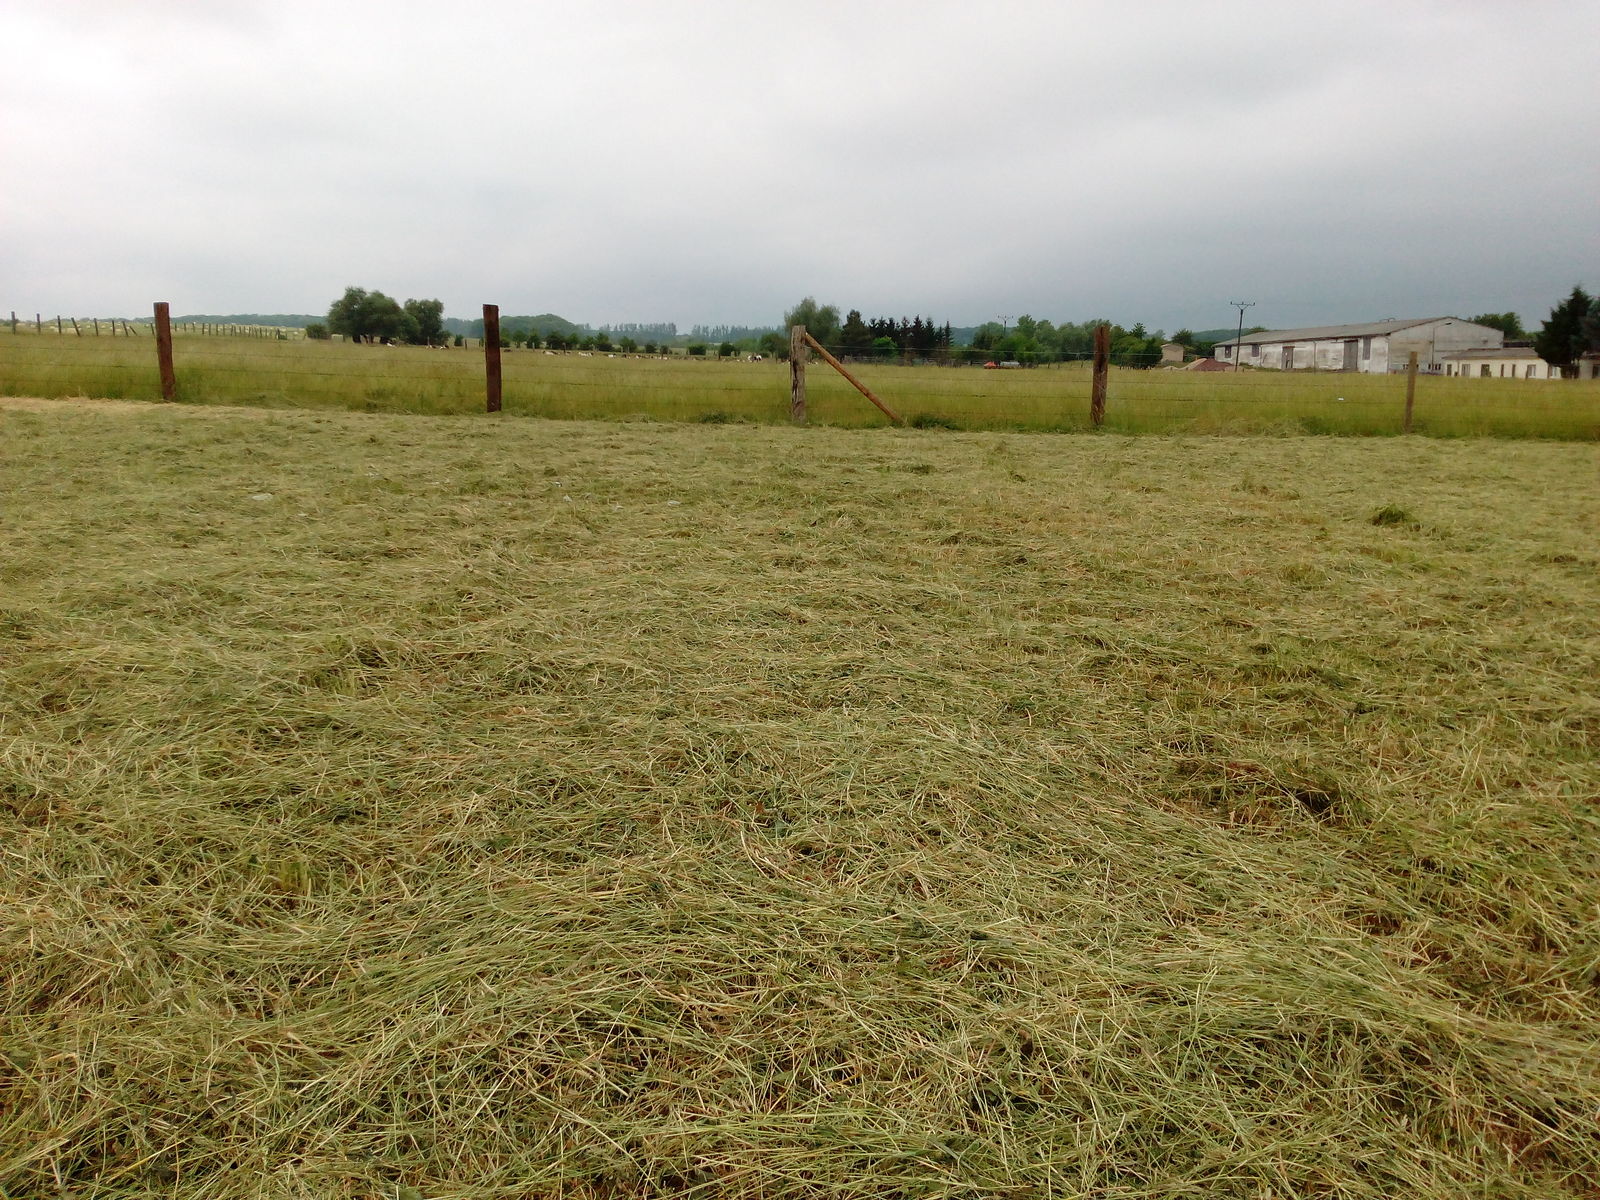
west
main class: Grassland
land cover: Grassland without tree/shrub cover
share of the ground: > 75 %
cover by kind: herbaceous plants 100 %
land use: Agriculture (excluding fallow land and kitchen gardens)
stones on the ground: < 10 %
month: June
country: DE
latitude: 51.0636
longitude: 10.6134
